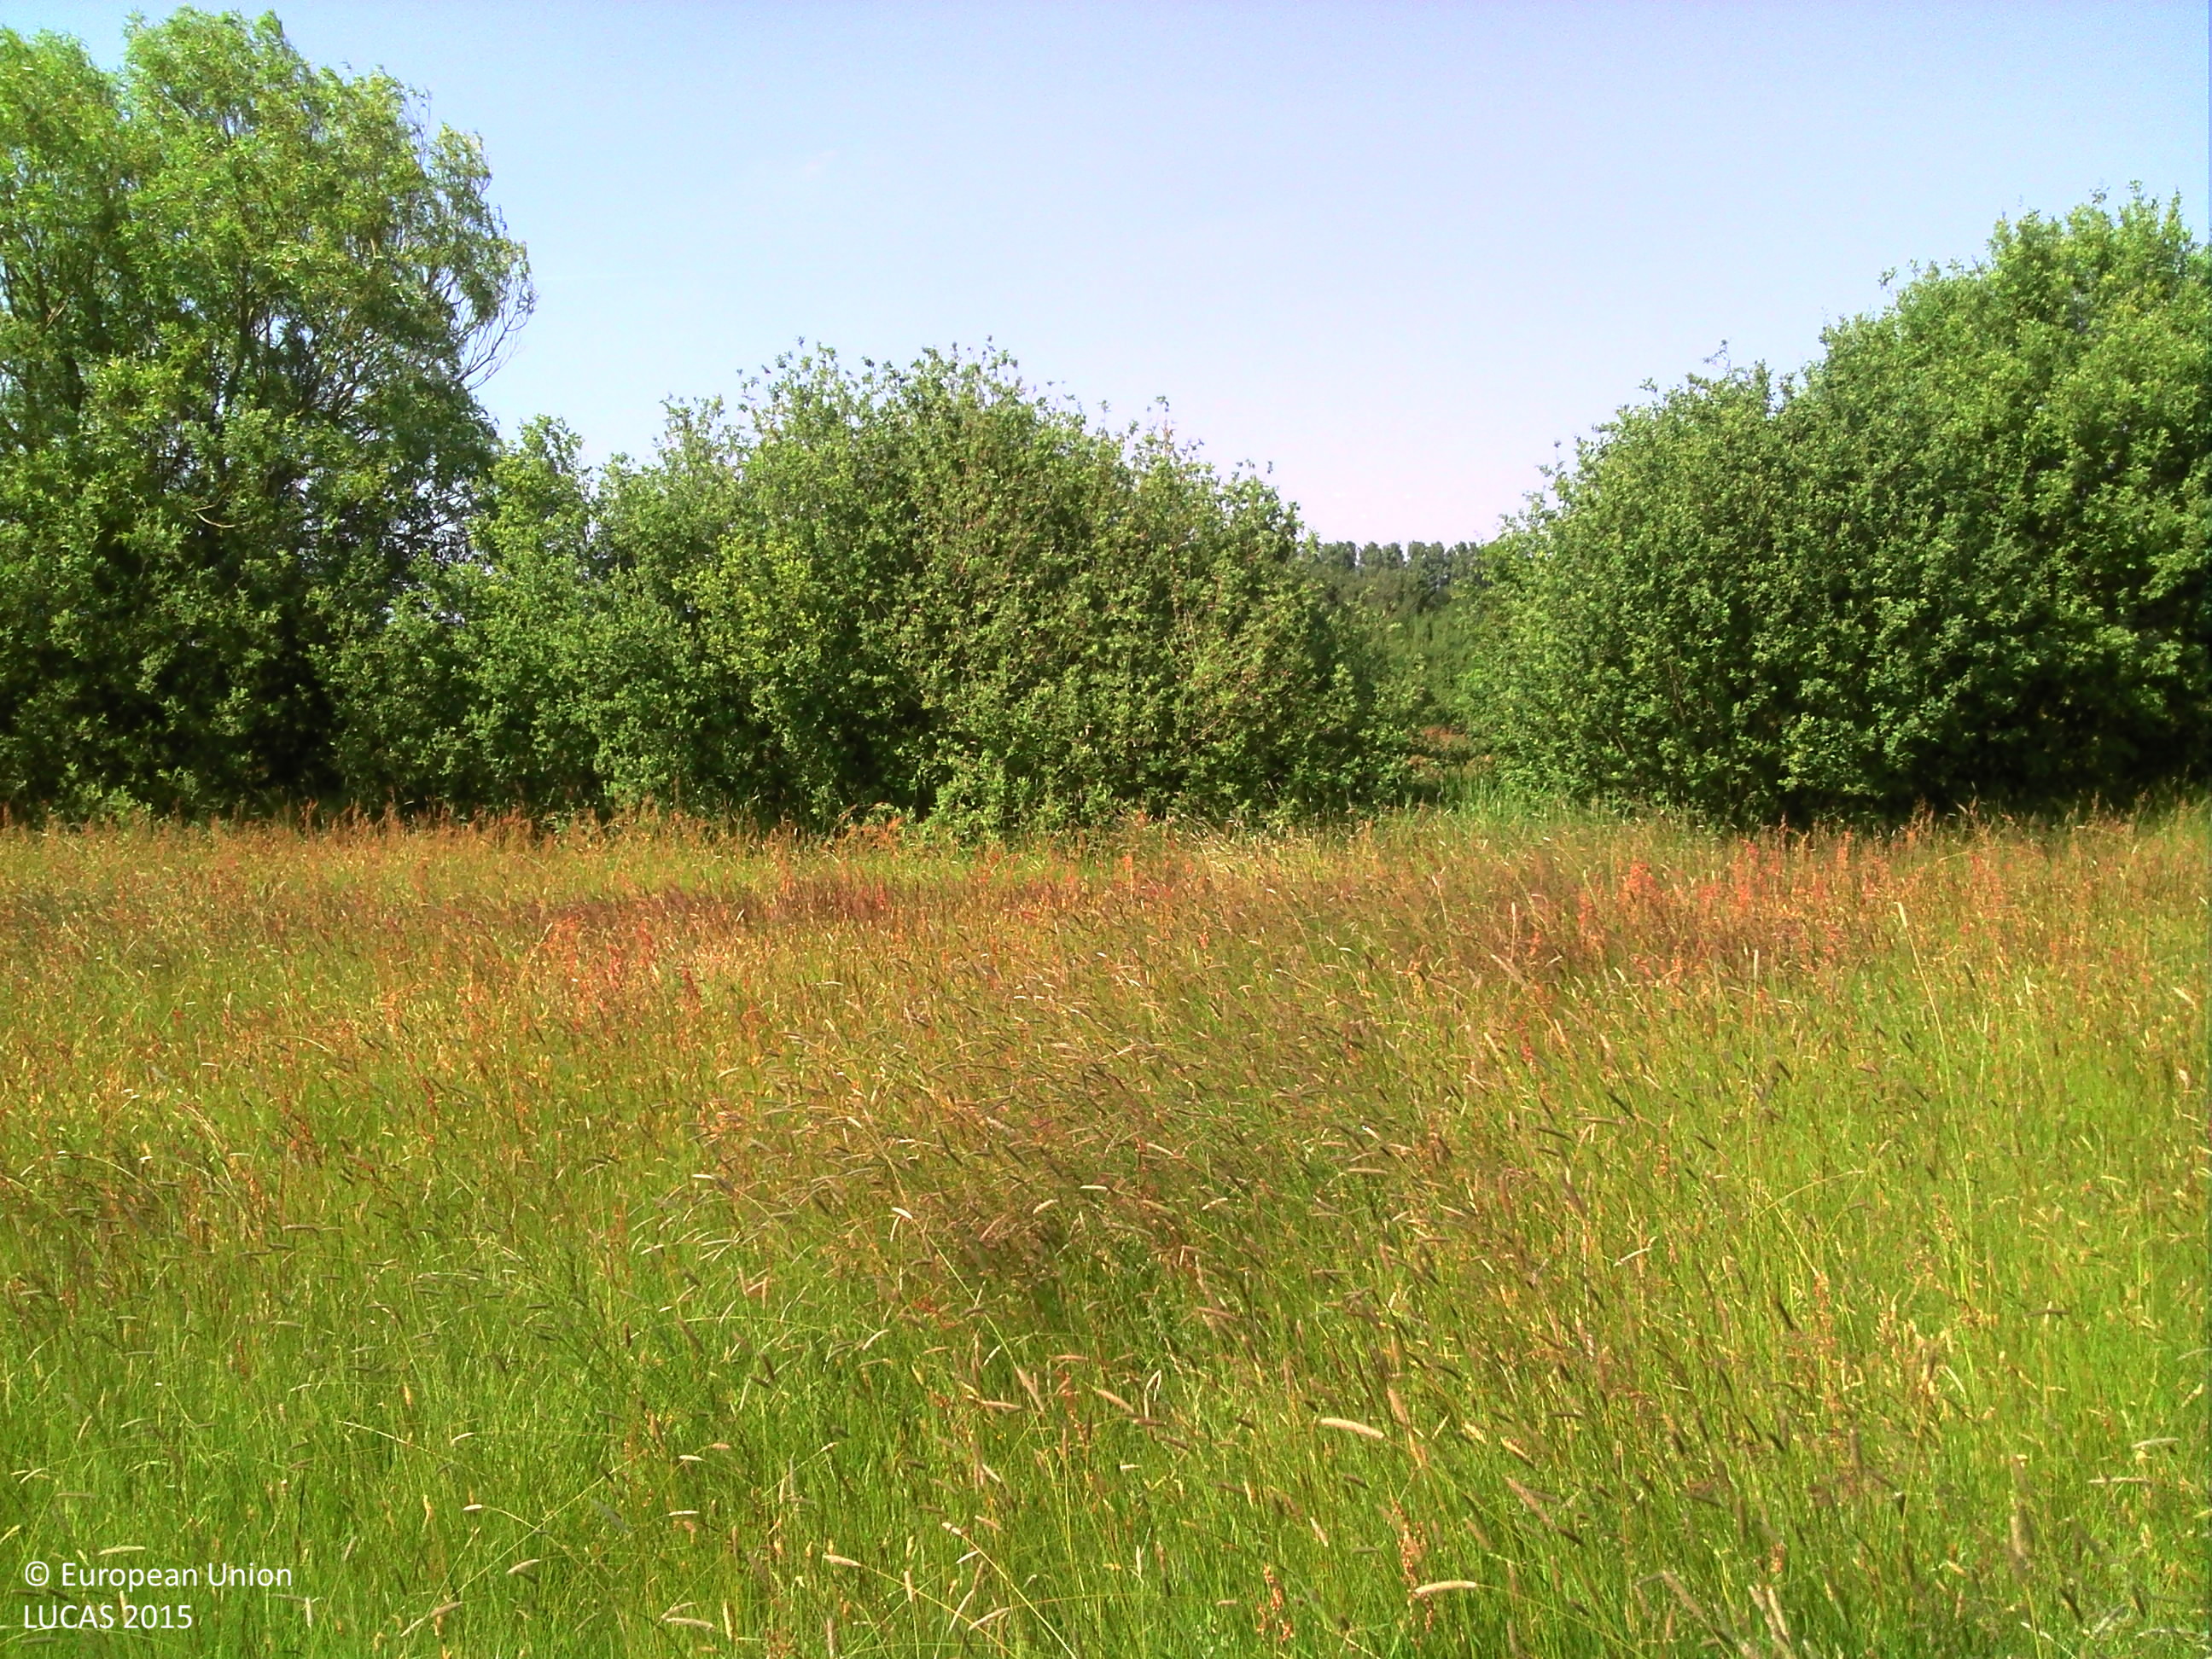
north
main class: Grassland
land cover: Grassland without tree/shrub cover
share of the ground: > 75 %
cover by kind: herbaceous plants 100 %
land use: Agriculture (excluding fallow land and kitchen gardens)
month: June
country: BE
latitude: 50.9646
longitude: 5.1705
